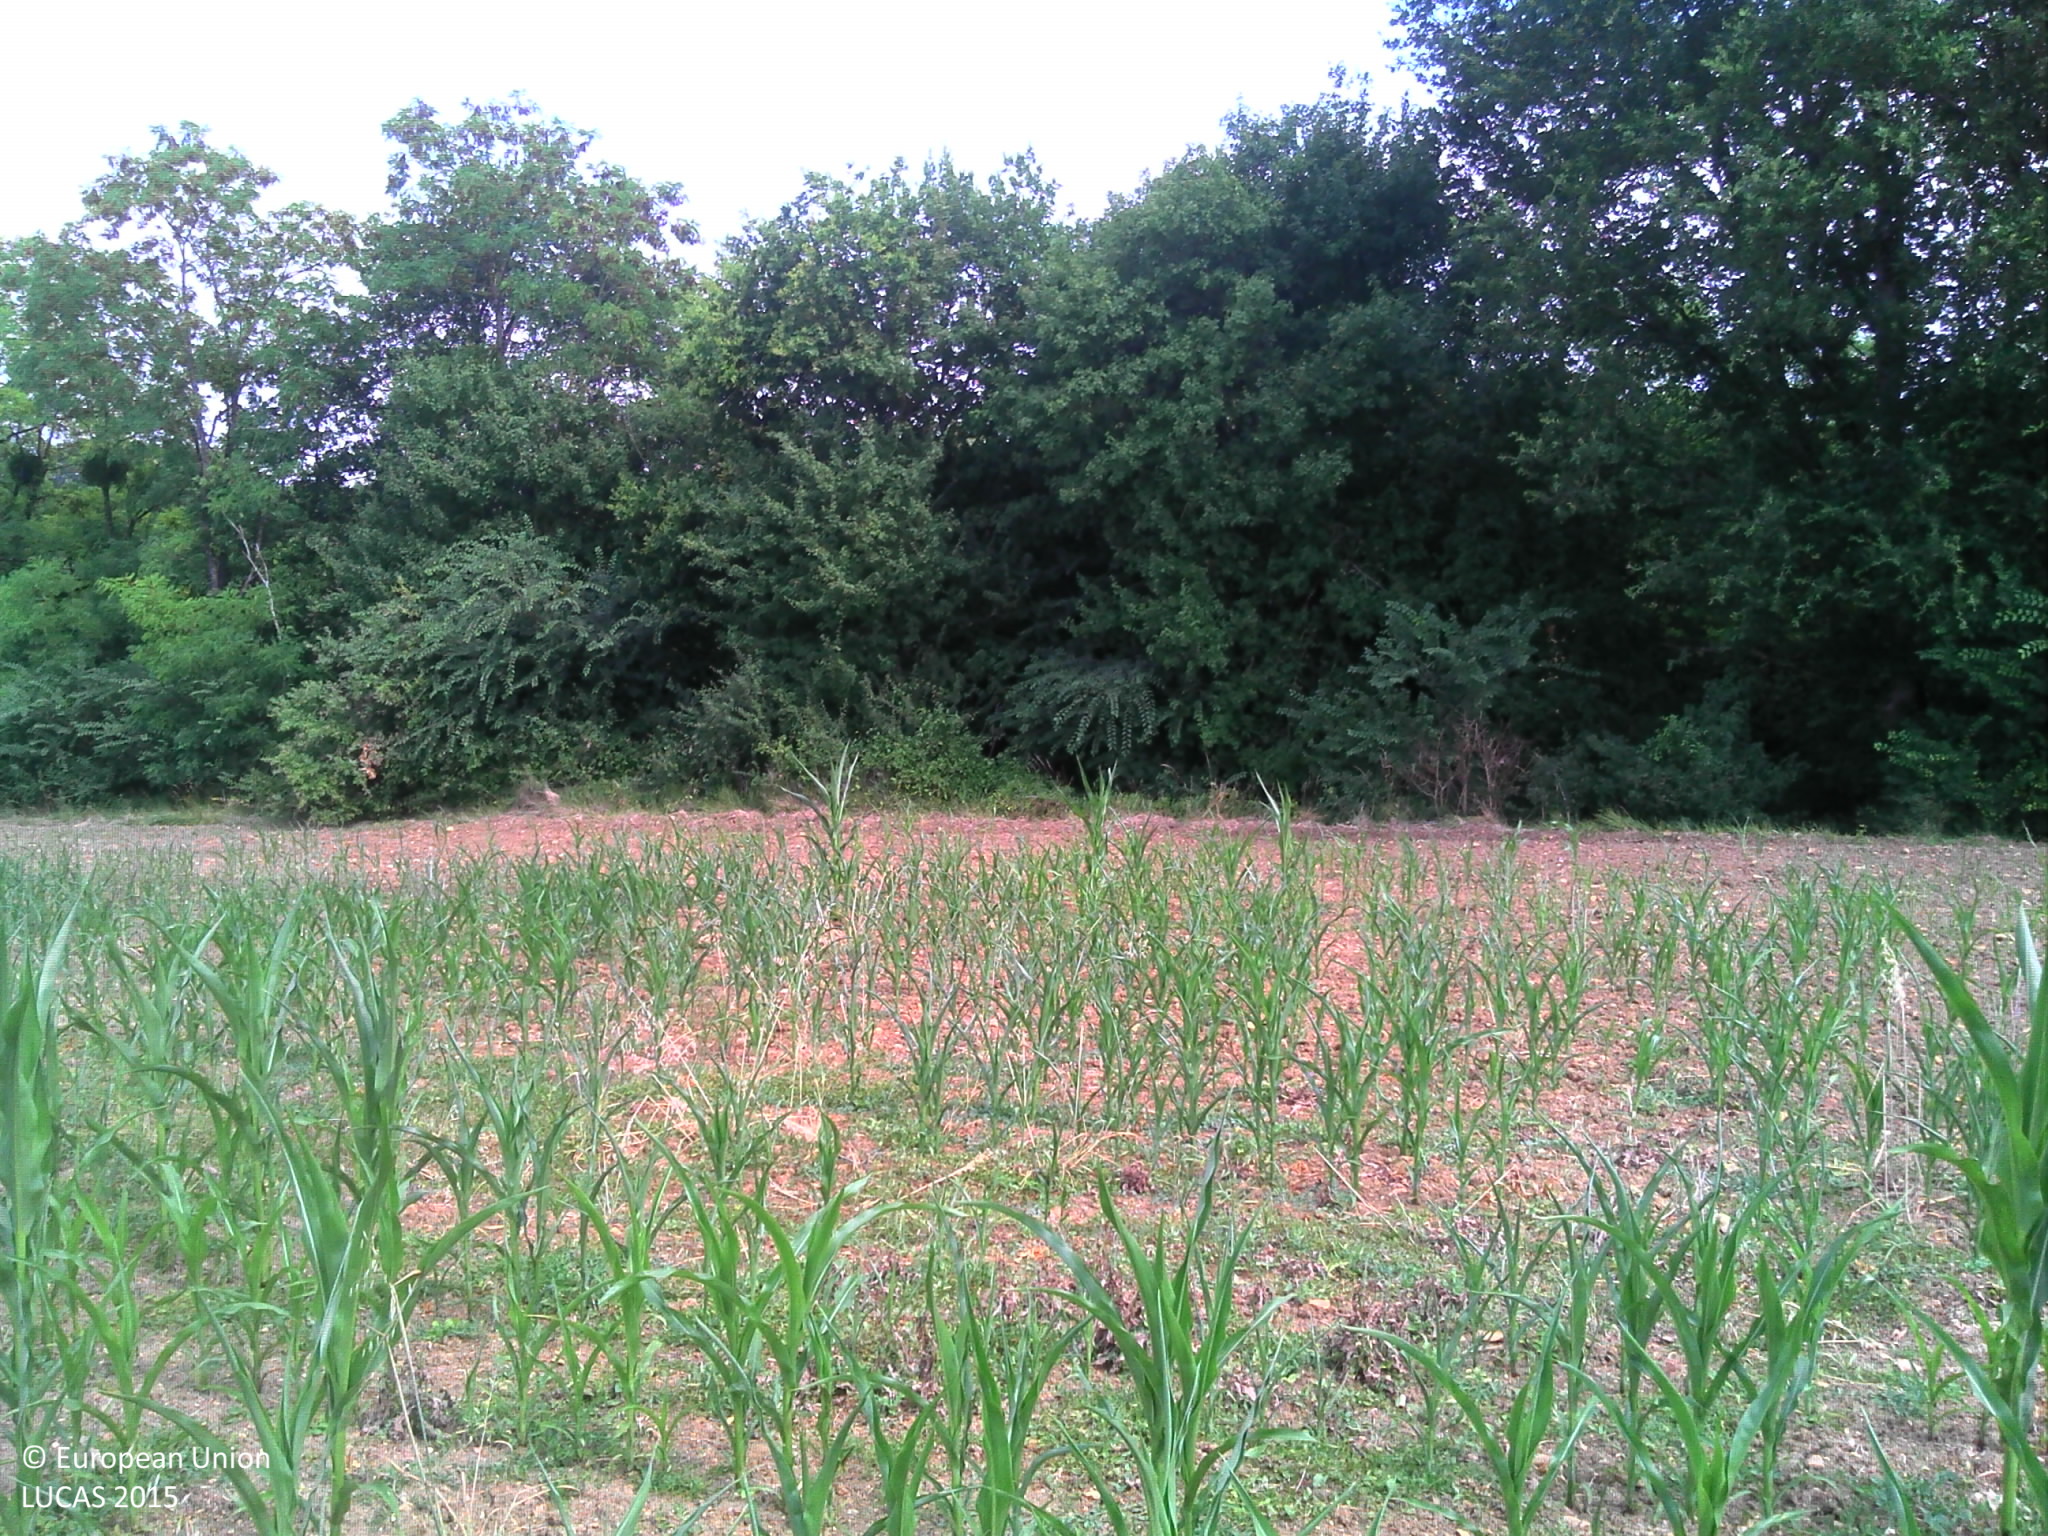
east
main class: Cropland
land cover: Maize
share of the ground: 25 - 50 %
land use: Agriculture (excluding fallow land and kitchen gardens)
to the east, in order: Maize; Broadleaved woodland; Grass margins; Paved roads, cycling and walking lanes; Grass margins; Ditches and canals; Broadleaved woodland; Fences; Grassland without tree/shrub cover; Fences; Managed hedges; Fences; Grassland without tree/shrub cover; Electric lines; Grassland without tree/shrub cover; Fences; Broadleaved woodland; Ditches and canals; Grass margins; Paved roads, cycling and walking lanes; Grass margins; Broadleaved woodland
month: July
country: FR
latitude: 47.2621
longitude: 0.4238
